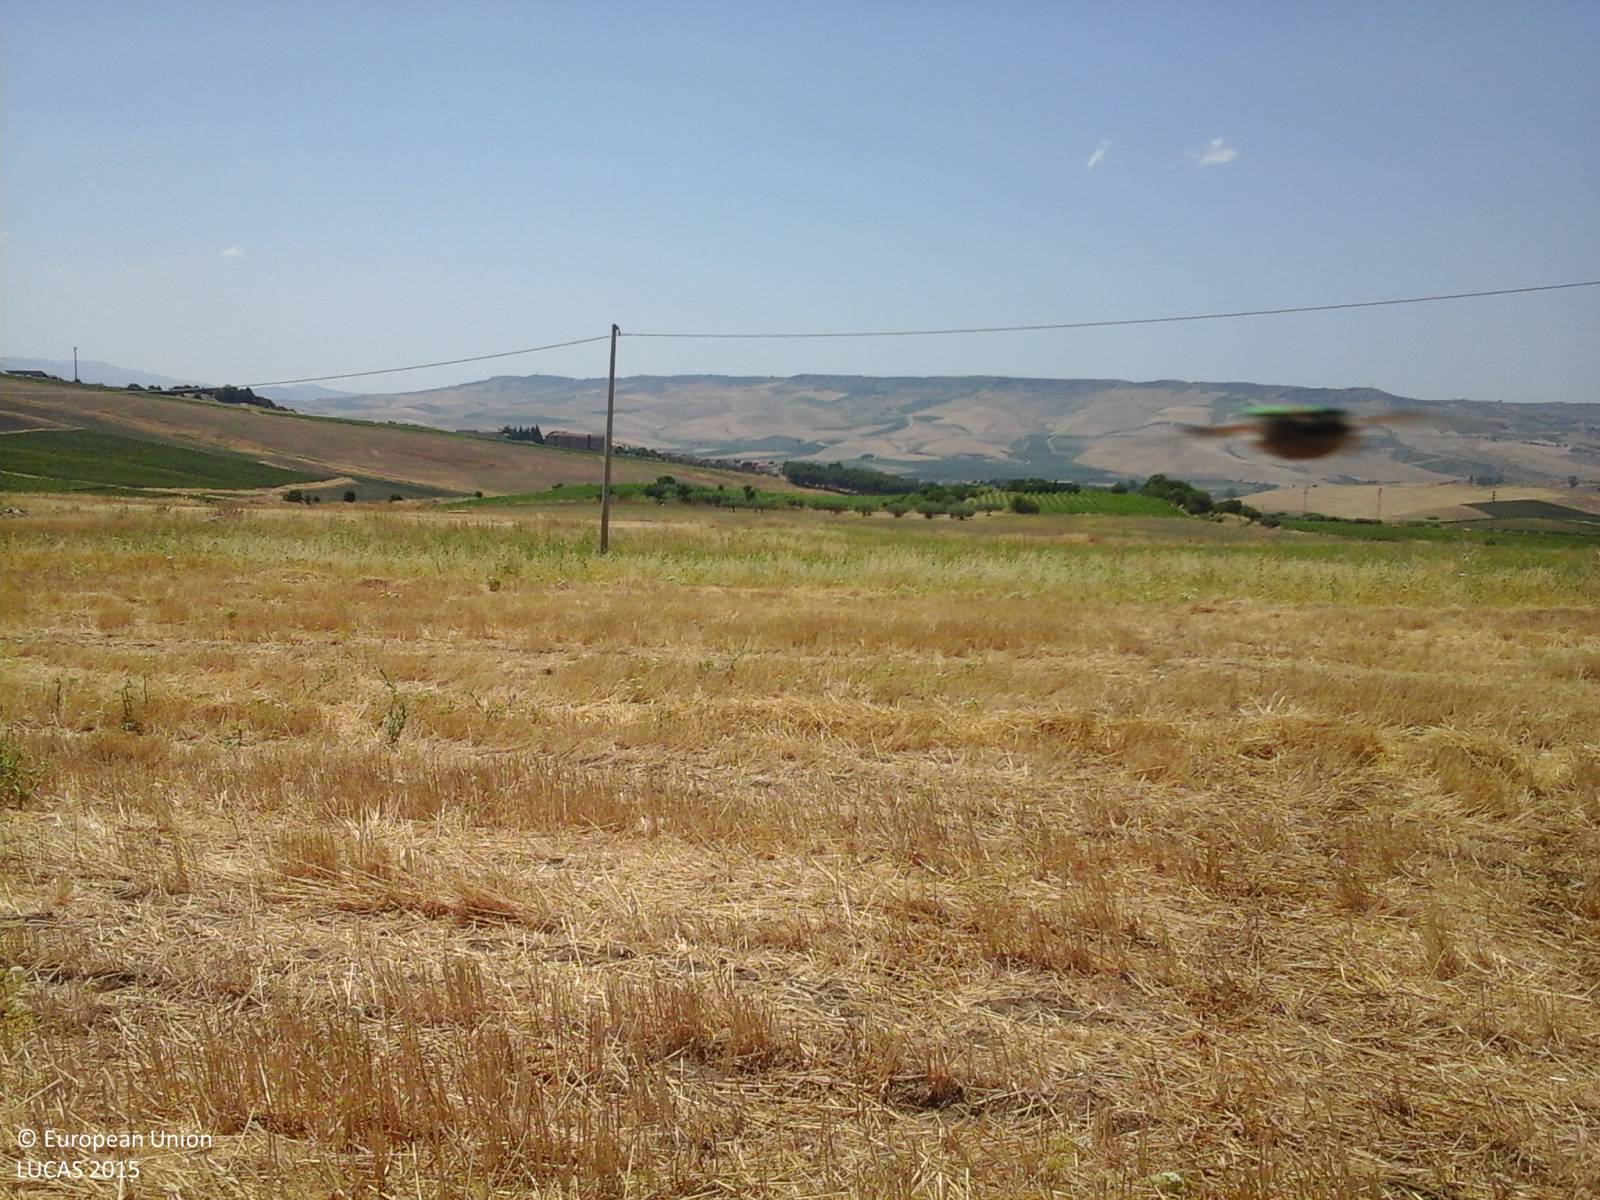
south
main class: Cropland
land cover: Durum wheat
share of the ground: > 75 %
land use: Agriculture (excluding fallow land and kitchen gardens)
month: July
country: IT
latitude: 37.7726
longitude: 13.0089
